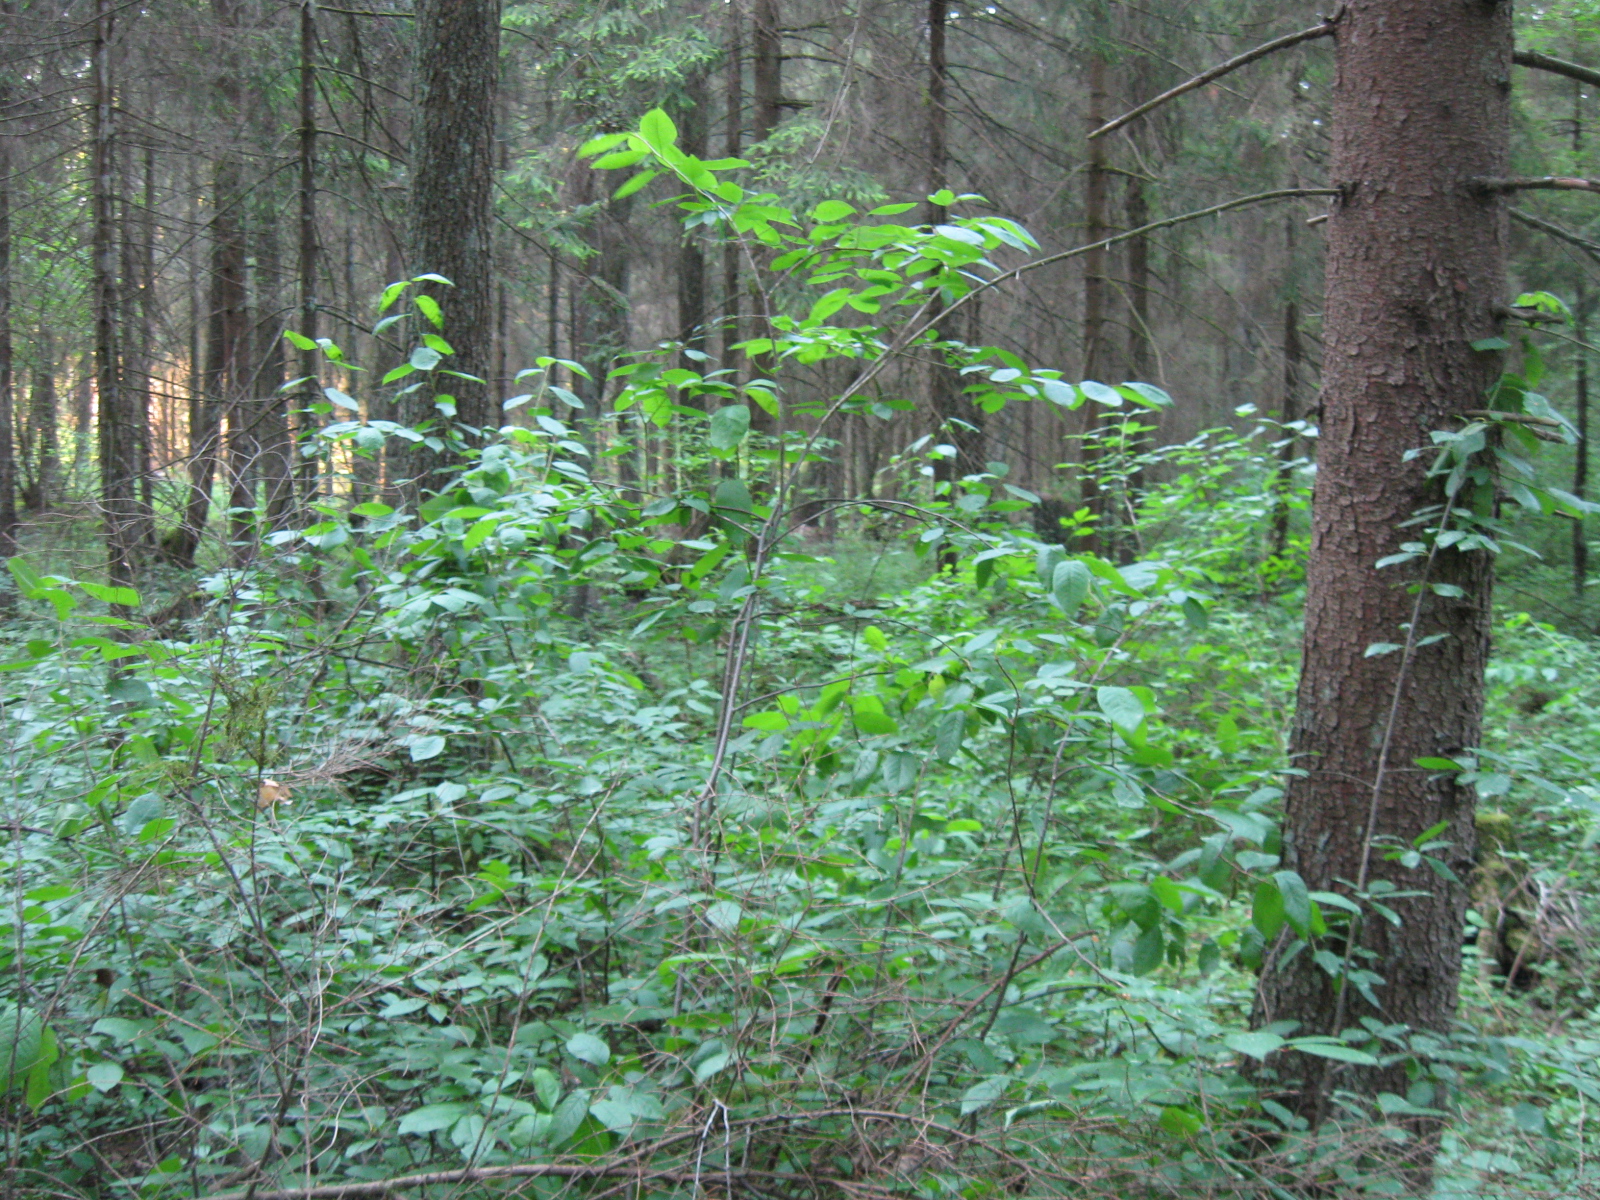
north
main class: Woodland
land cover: Spruce dominated mixed woodland
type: hemiboreal forest and nemoral coniferous forest and mixed broadleaved-coniferous forest
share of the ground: > 75 %
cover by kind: coniferous forest trees 70 %, broadleaved forest trees 30 %
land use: Forestry
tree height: > 5 m
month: June
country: LT
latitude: 54.1518
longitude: 23.6984
